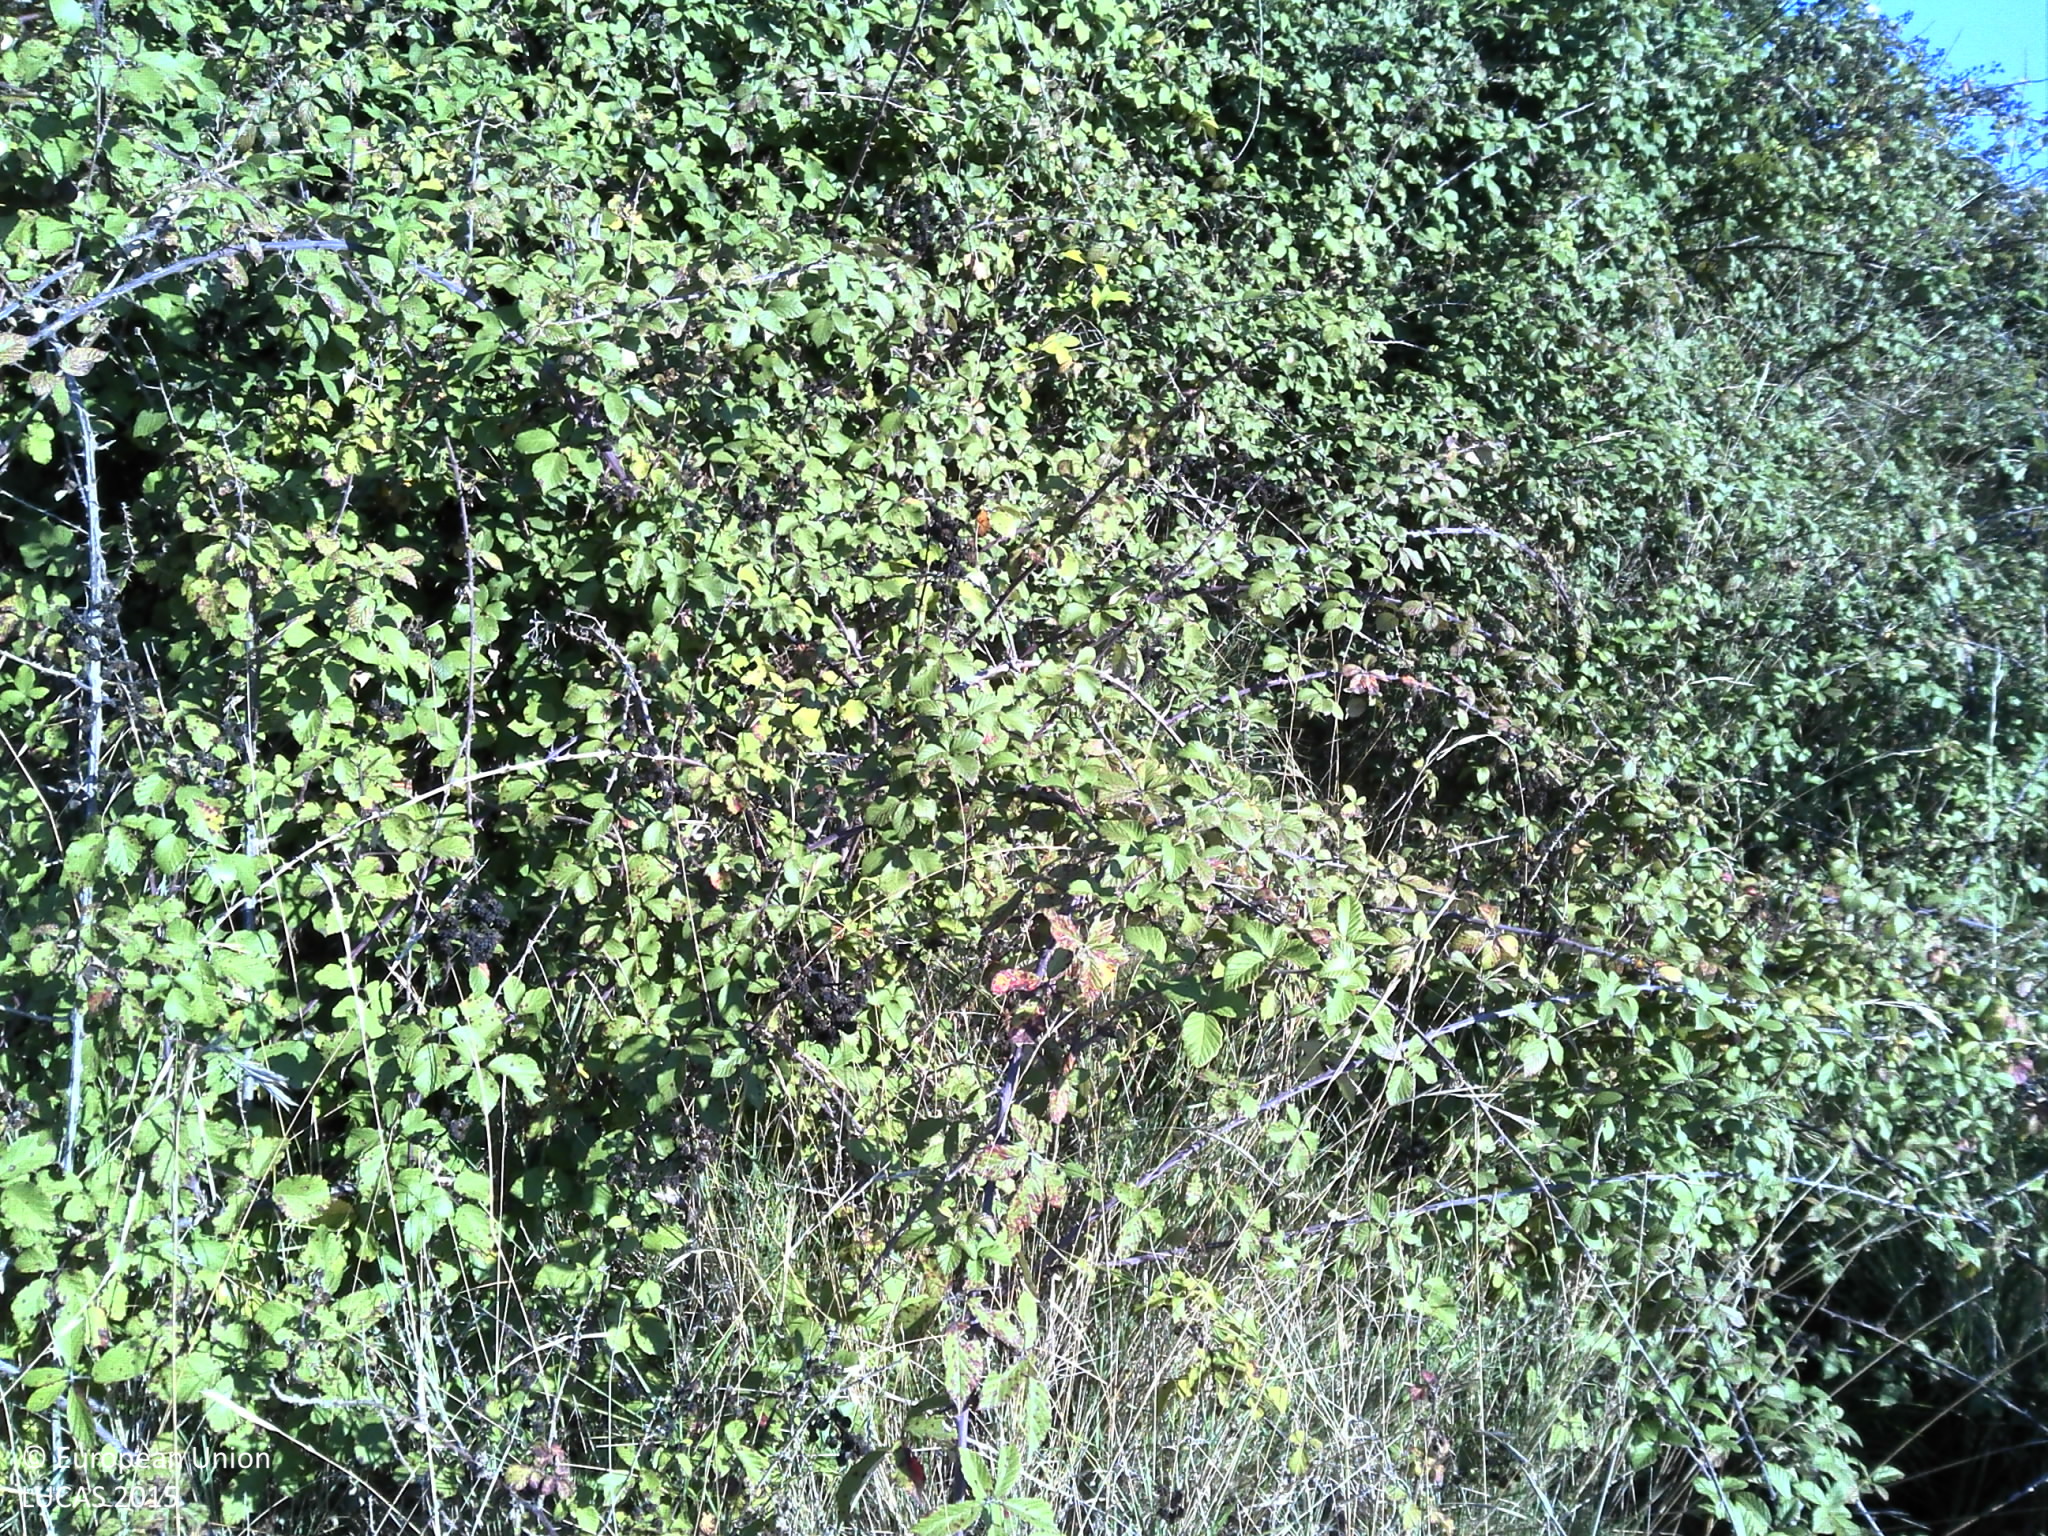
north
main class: Shrubland
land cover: Shrubland with sparse tree cover
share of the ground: > 75 %
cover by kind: shrubs 85 %, herbaceous plants 10 %, broadleaved forest trees 5 %
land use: Semi-natural and natural areas not in use
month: October
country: FR
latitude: 43.2567
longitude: 3.1732
